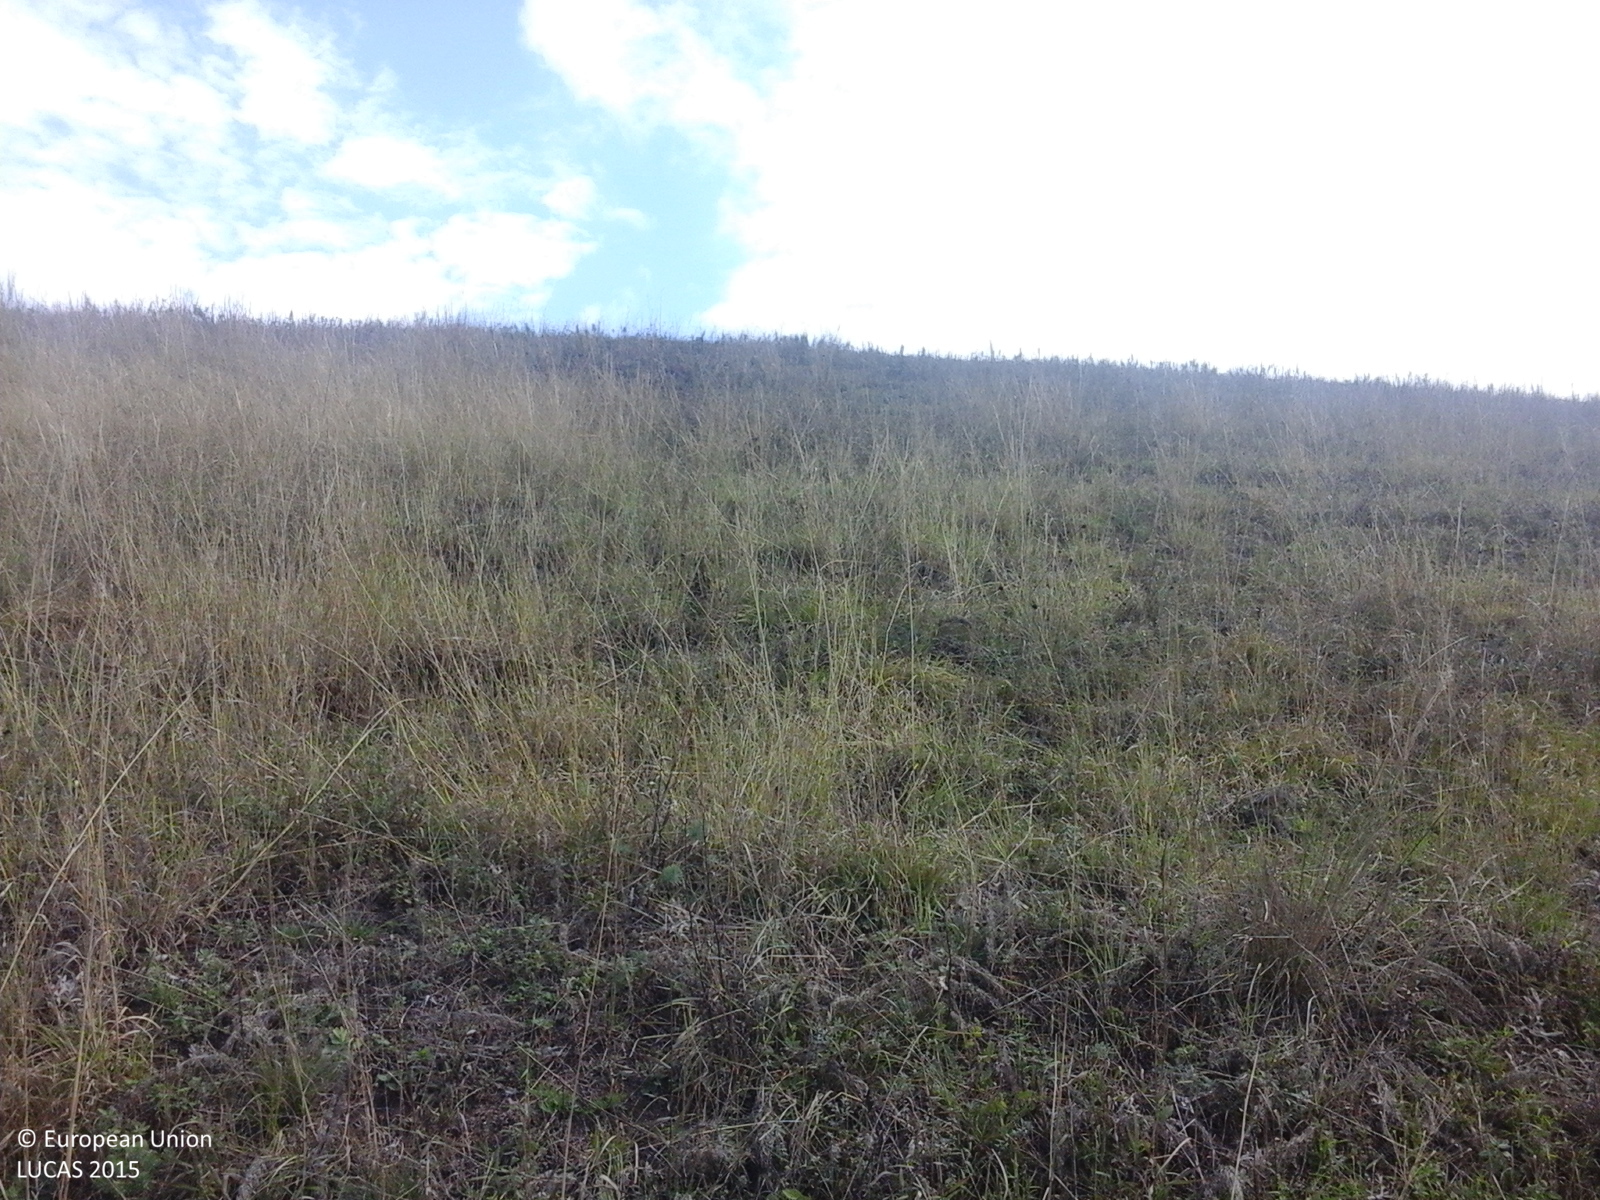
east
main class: Grassland
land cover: Grassland without tree/shrub cover
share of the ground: > 75 %
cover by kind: herbaceous plants 100 %
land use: Agriculture (excluding fallow land and kitchen gardens)
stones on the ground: < 10 %
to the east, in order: Grassland without tree/shrub cover
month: September
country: RO
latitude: 46.0629
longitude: 23.7329
